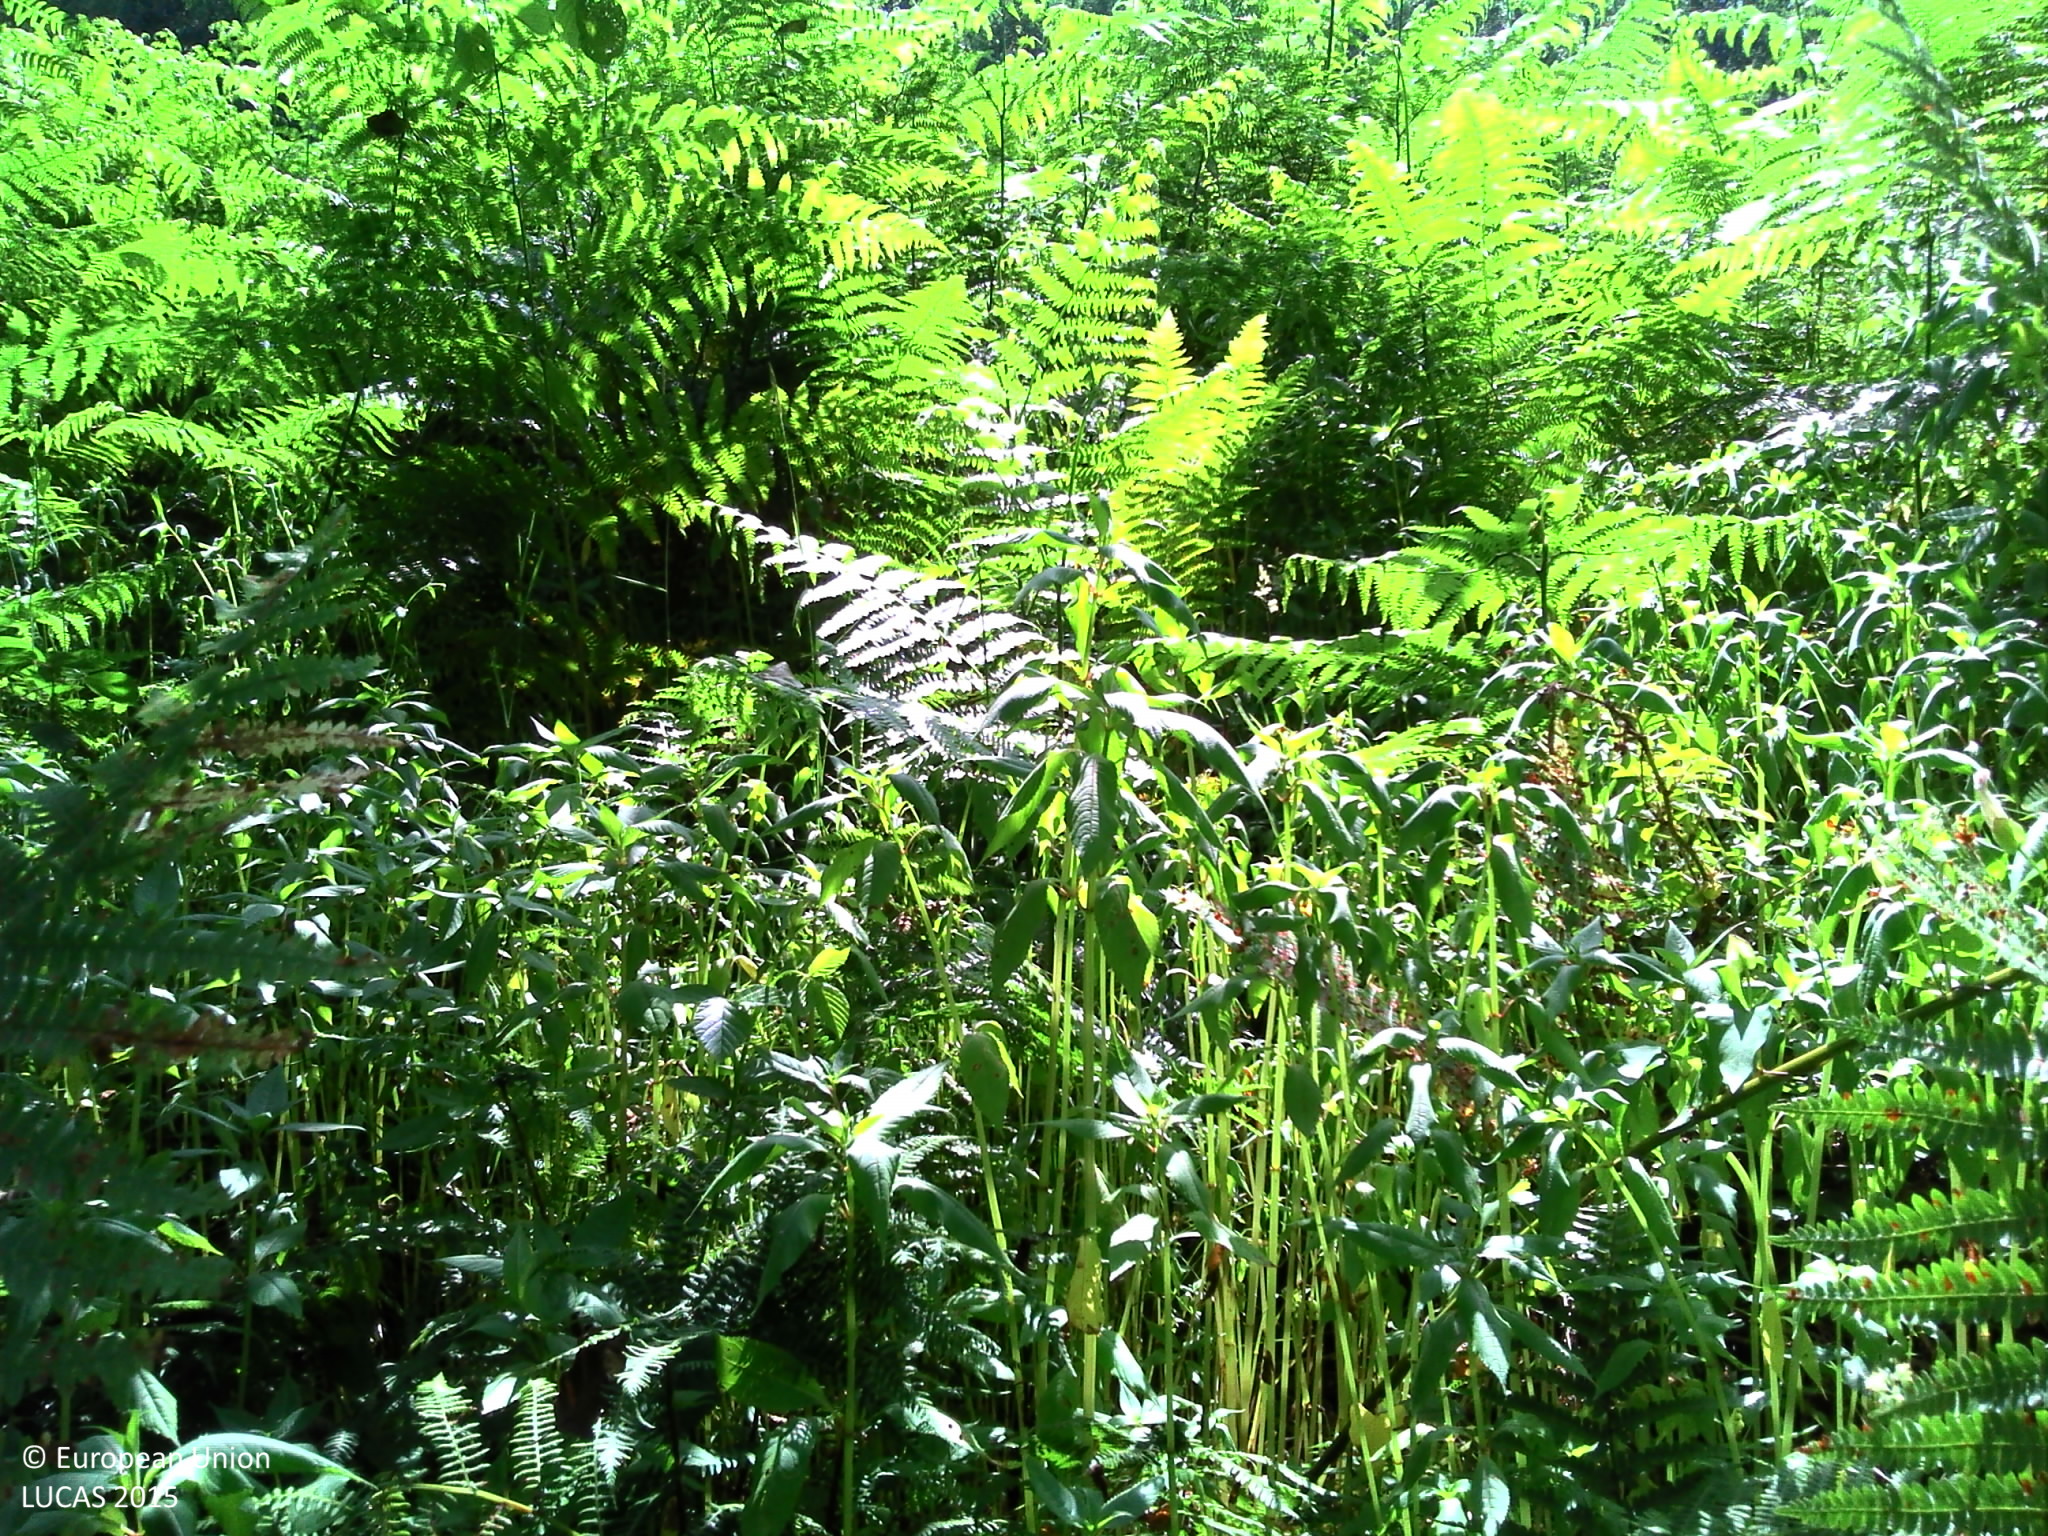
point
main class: Shrubland
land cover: Shrubland without tree cover
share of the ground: > 75 %
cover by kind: shrubs 40 %, herbaceous plants 30 %, lichens and mosses 30 %
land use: Semi-natural and natural areas not in use
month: July
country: FR
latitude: 43.0053
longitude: 0.8884
